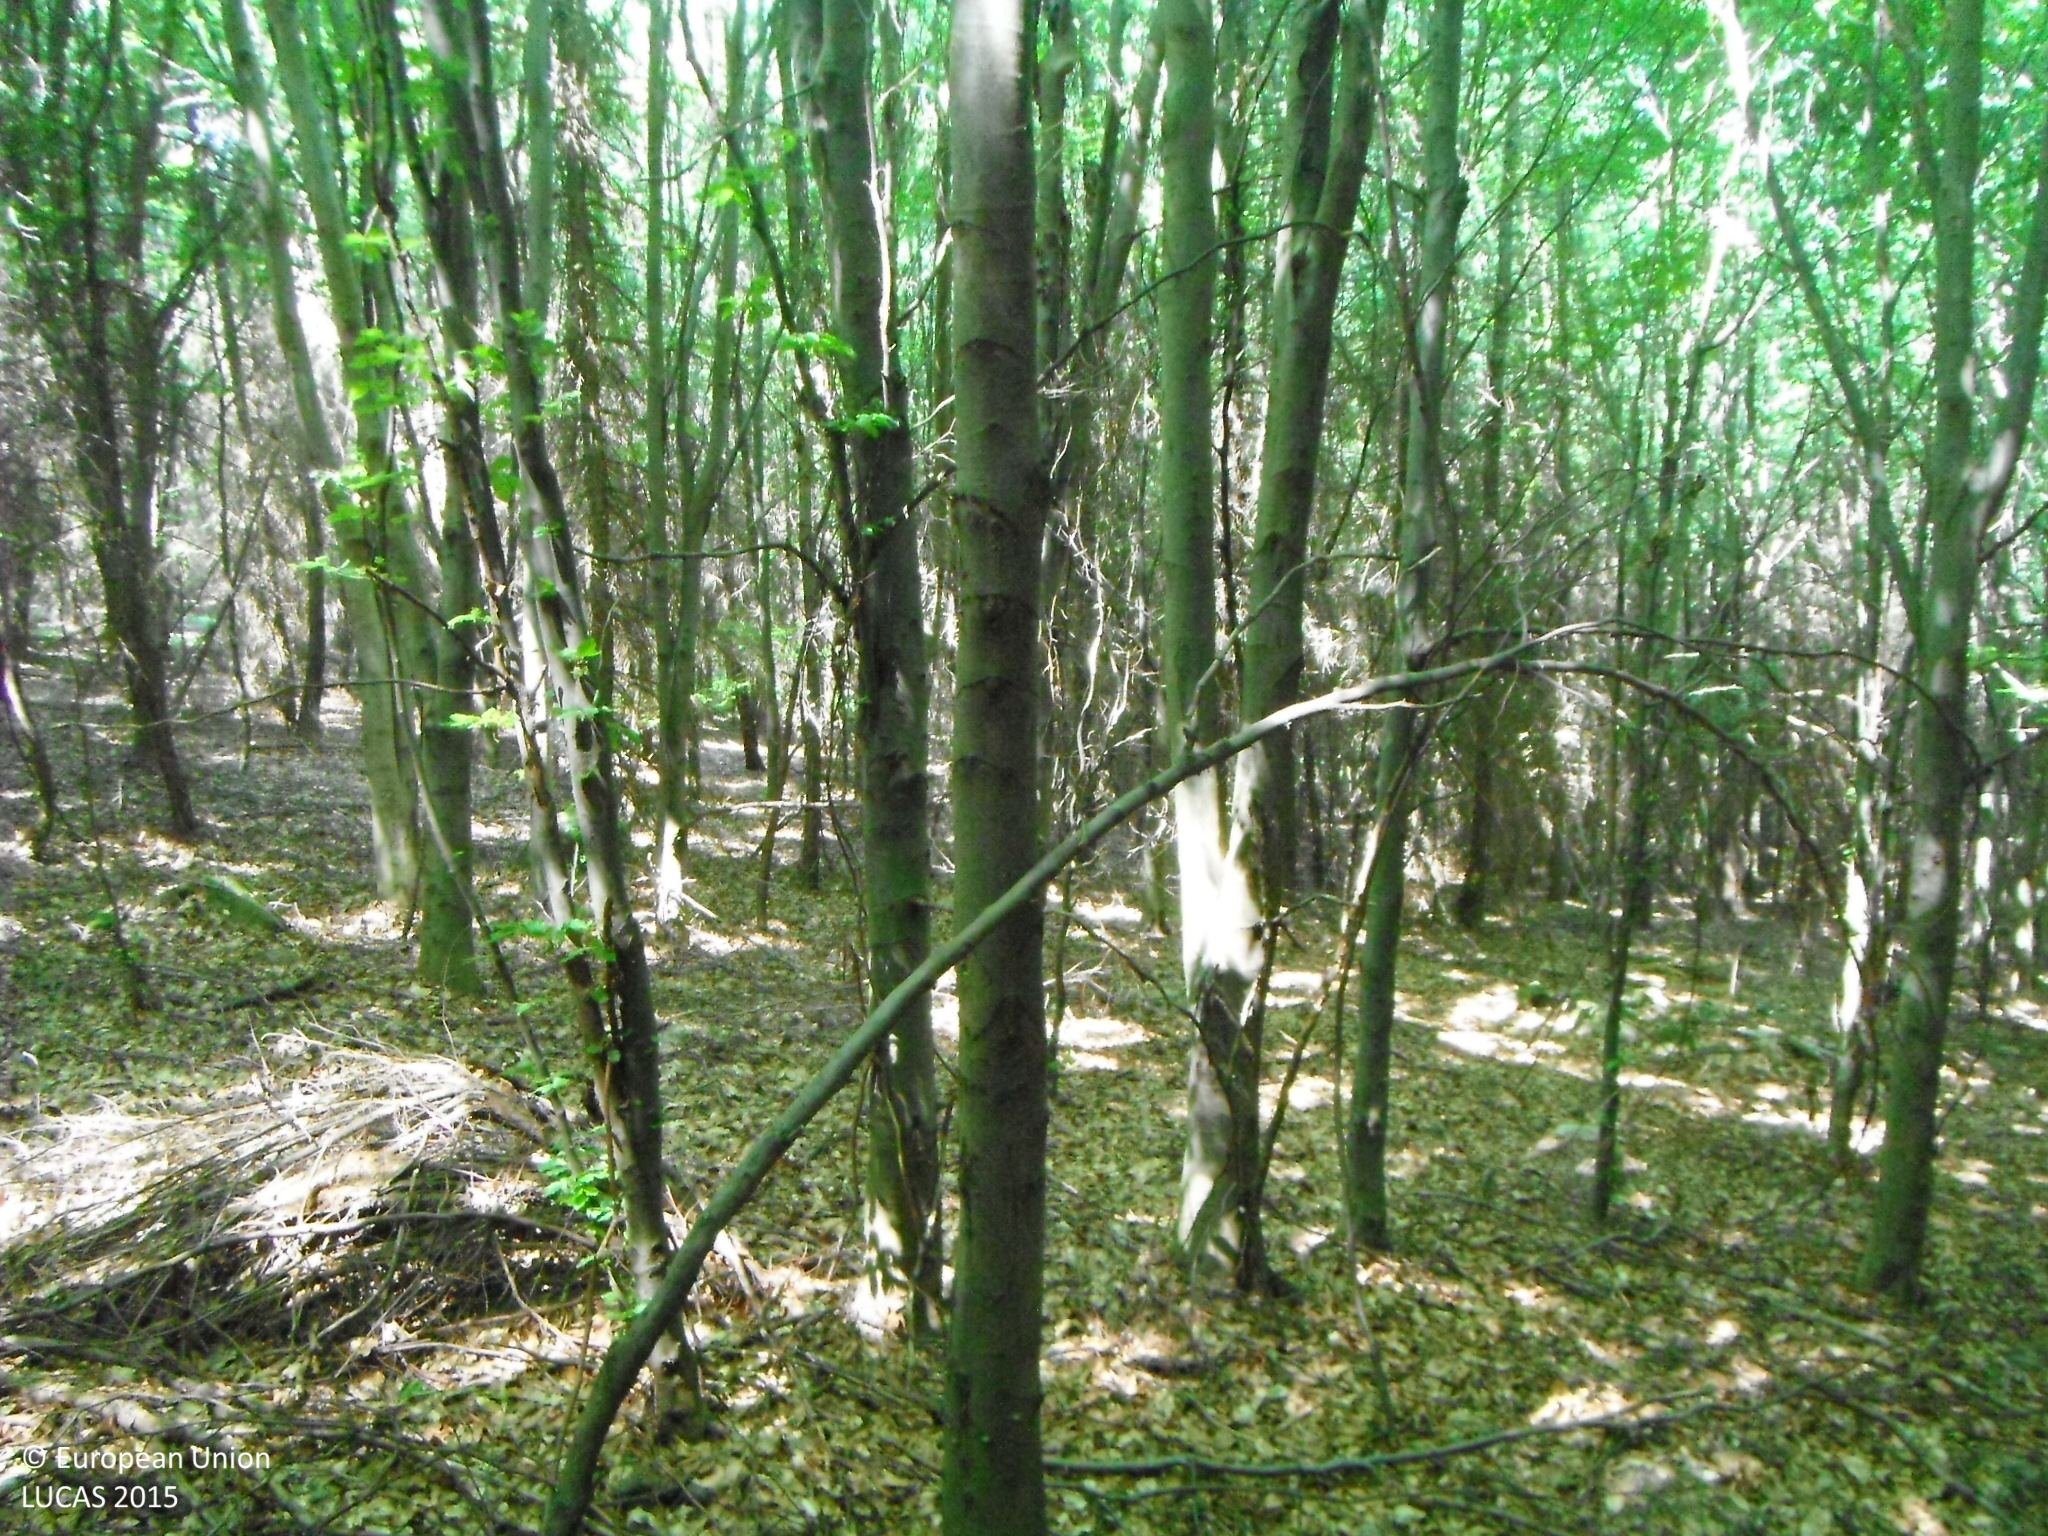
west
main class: Woodland
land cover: Spruce dominated mixed woodland
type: alpine coniferous forest
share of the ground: > 75 %
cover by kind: coniferous forest trees 50 %, broadleaved forest trees 50 %
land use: Forestry
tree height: > 5 m
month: July
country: SK
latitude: 48.5115
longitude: 19.1592
